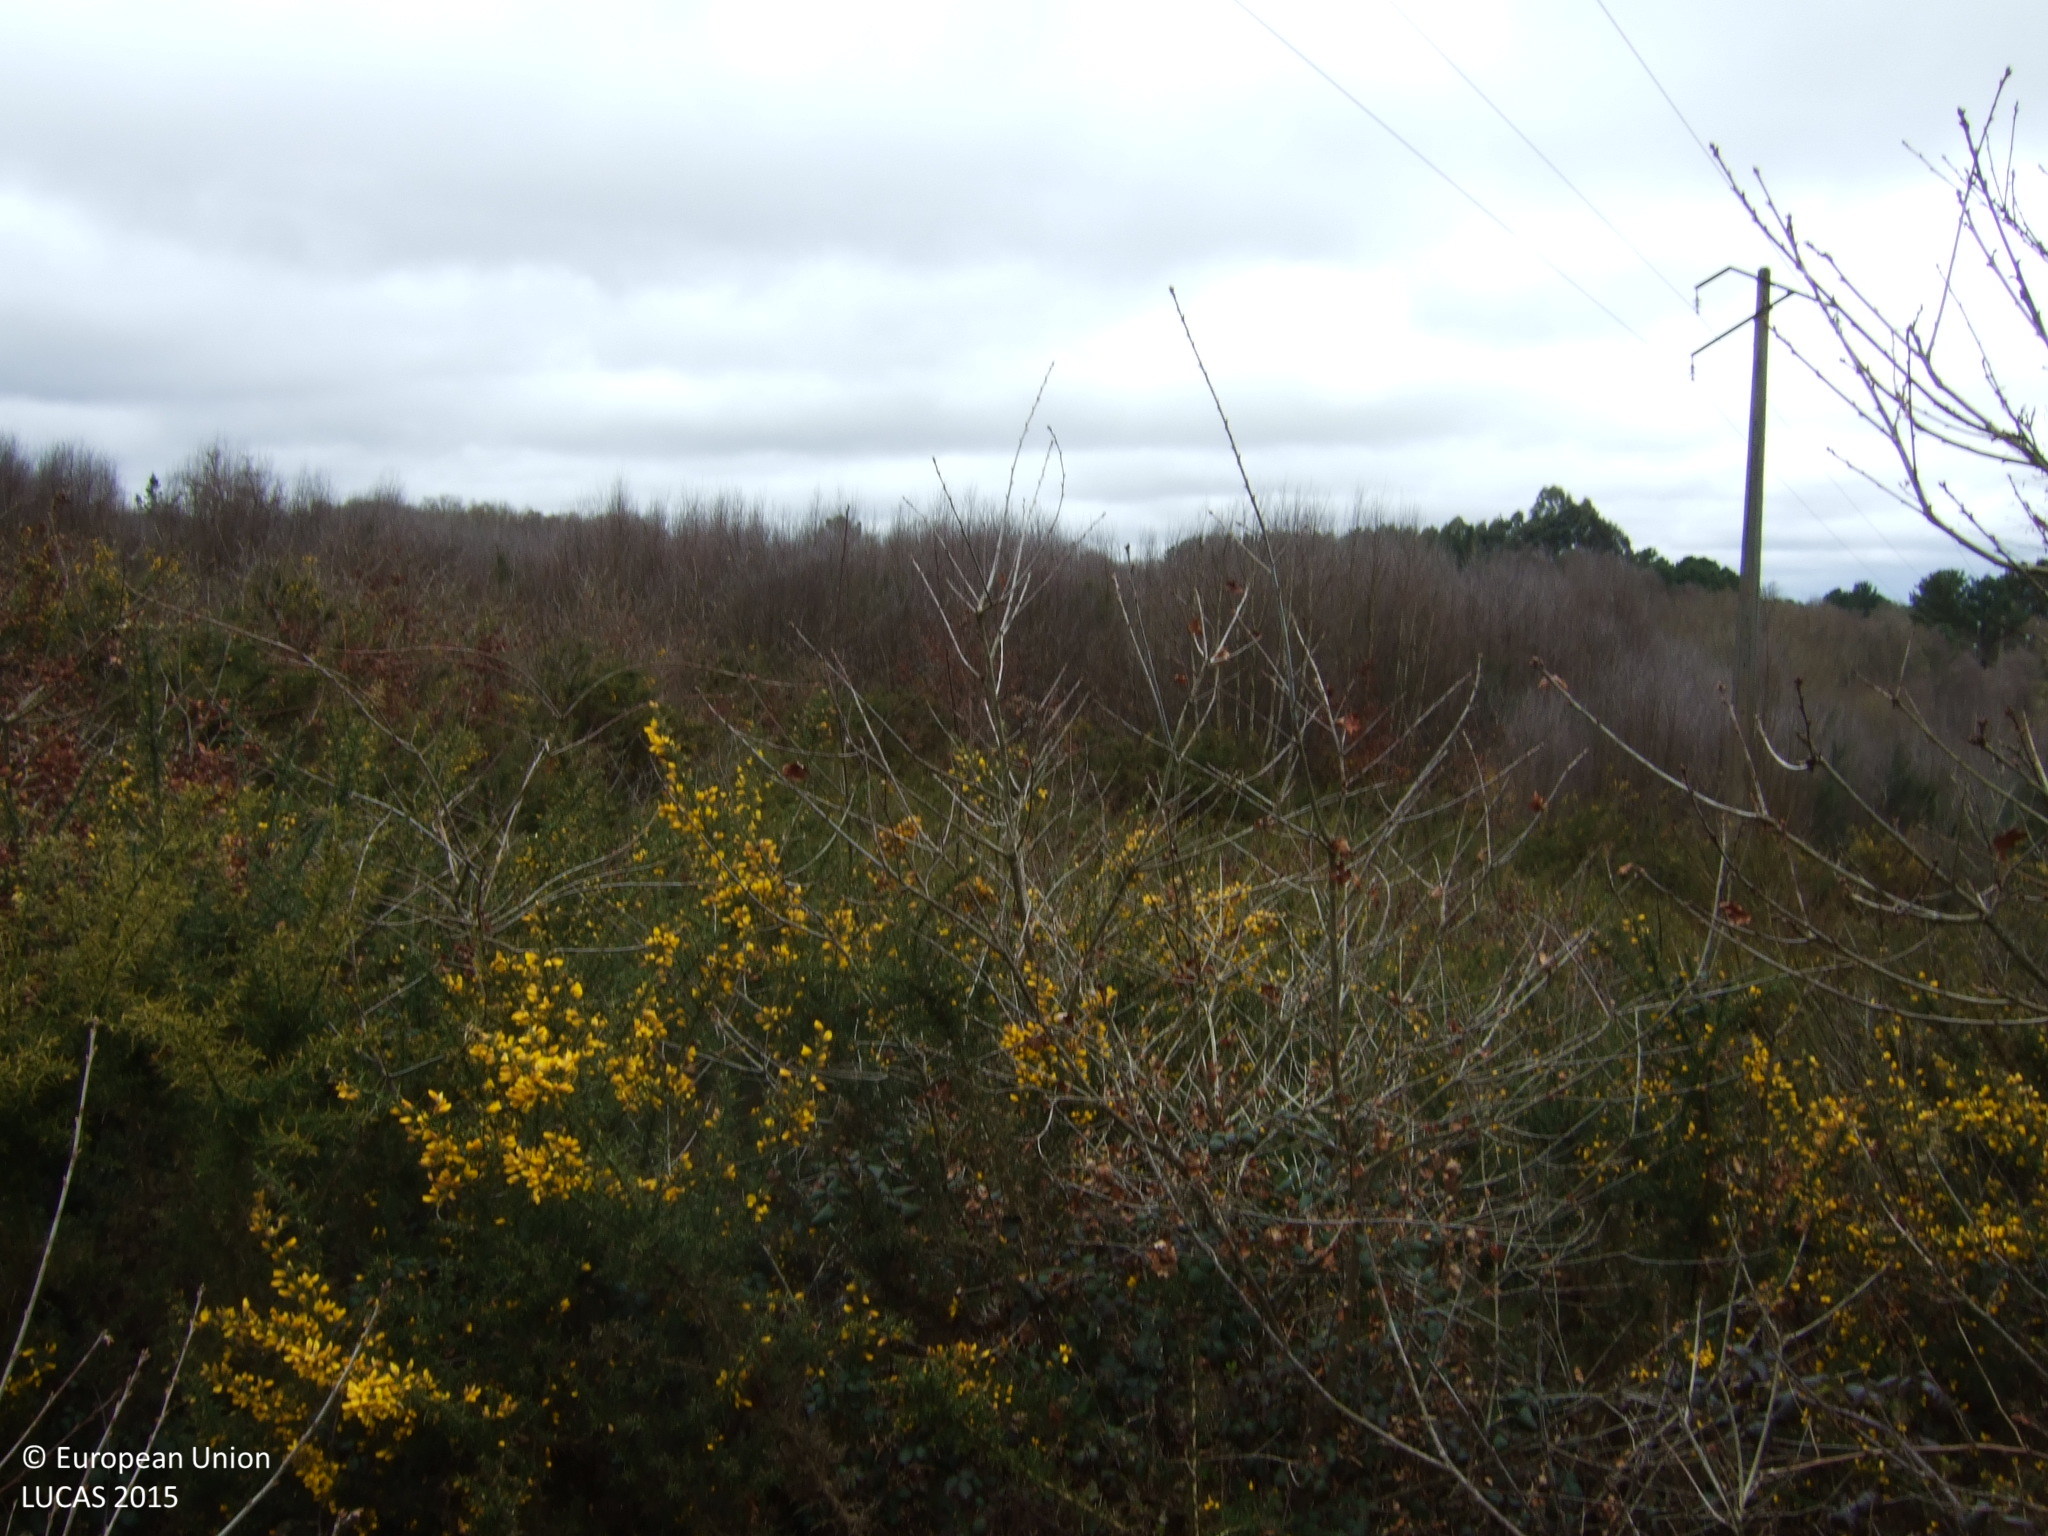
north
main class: Woodland
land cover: Broadleaved woodland
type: acidophilous oak and oak-birch forest
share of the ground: > 75 %
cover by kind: broadleaved forest trees 90 %, shrubs 10 %
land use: Semi-natural and natural areas not in use
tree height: > 5 m
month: March
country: ES
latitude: 42.9789
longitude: -7.6012
